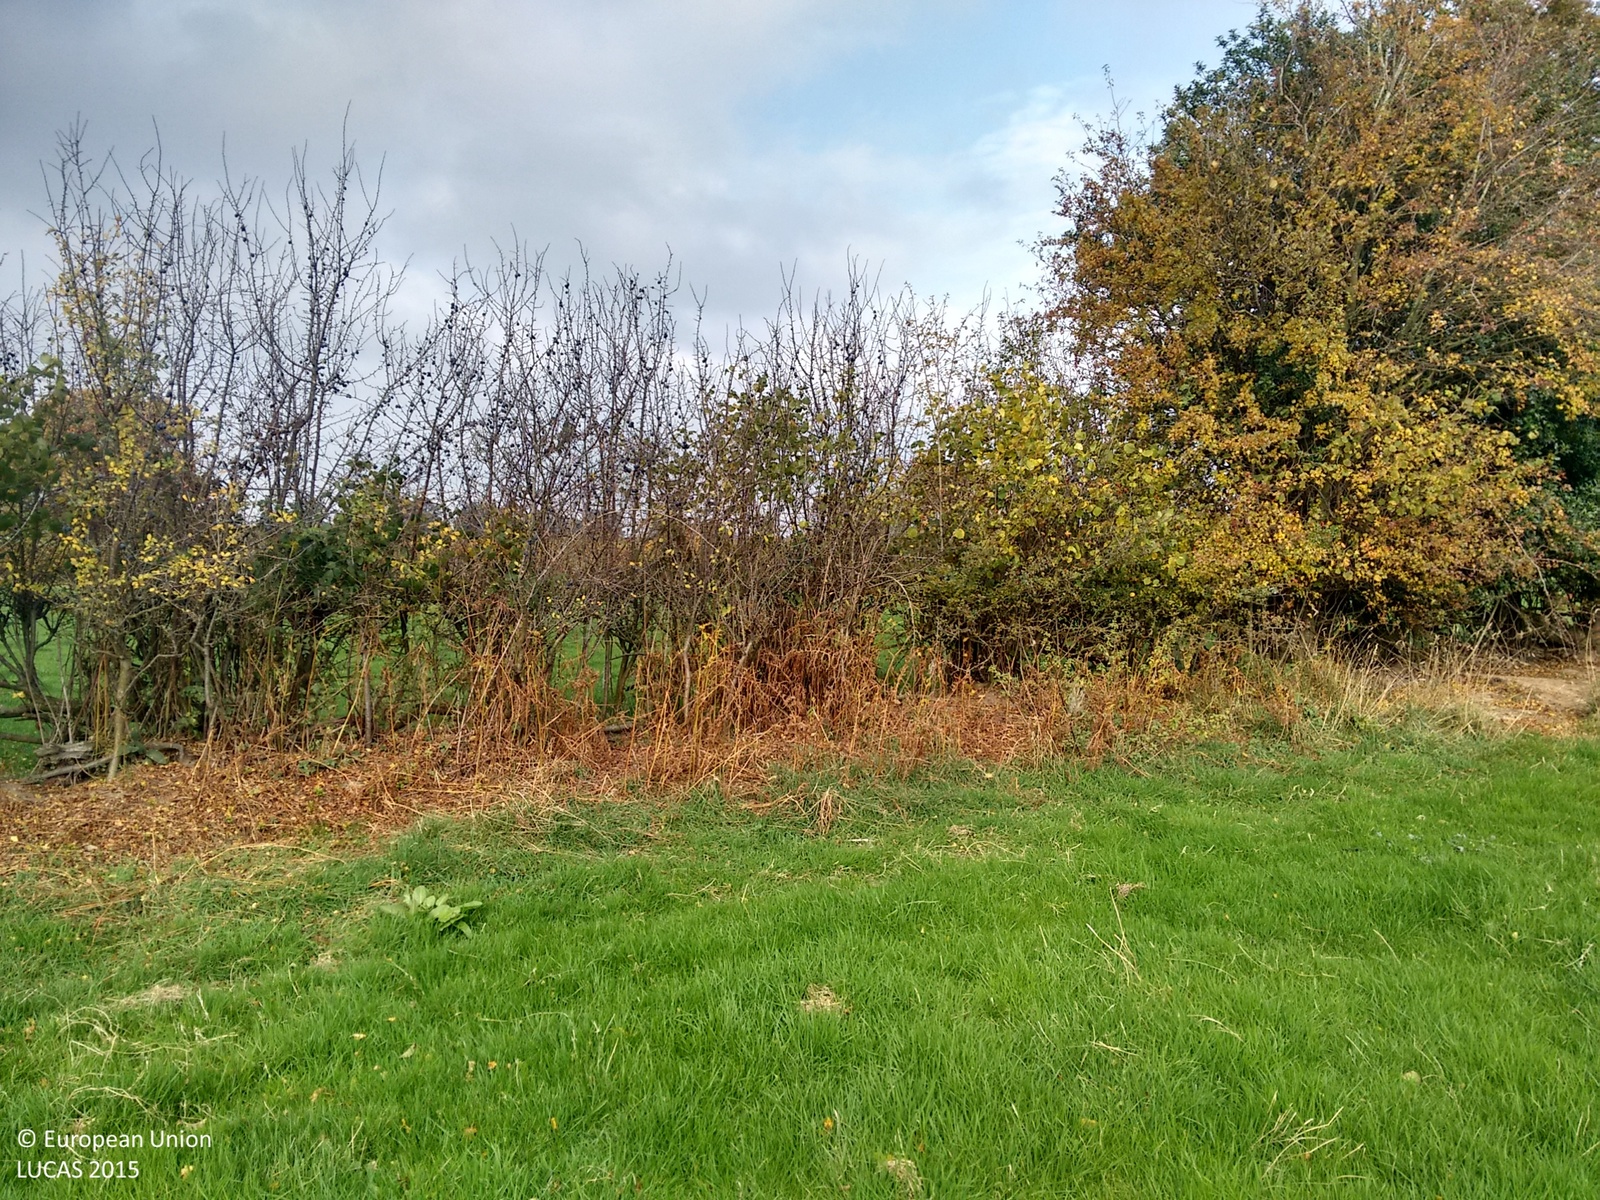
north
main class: Grassland
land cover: Grassland without tree/shrub cover
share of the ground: > 75 %
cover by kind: herbaceous plants 100 %
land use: Agriculture (excluding fallow land and kitchen gardens)
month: October
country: GB
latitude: 52.5936
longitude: -2.7813
